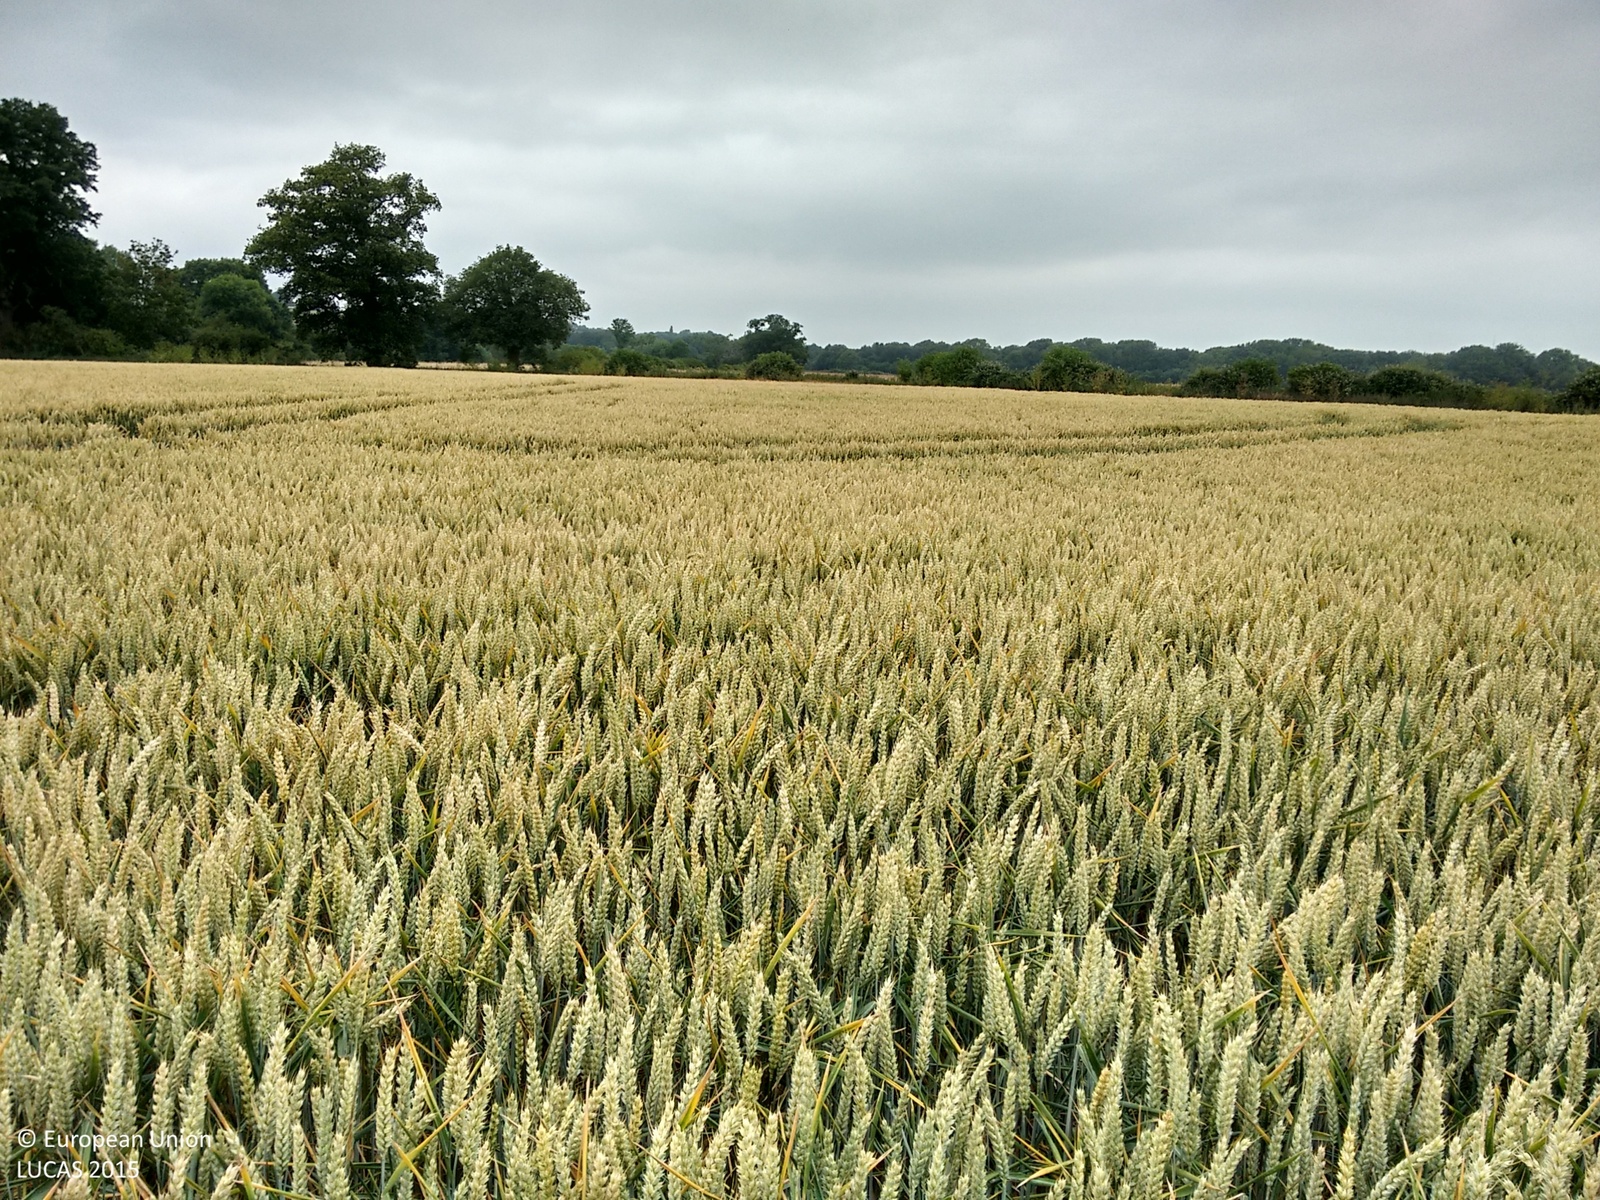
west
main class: Cropland
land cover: Common wheat
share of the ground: > 75 %
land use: Agriculture (excluding fallow land and kitchen gardens)
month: July
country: GB
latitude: 51.7615
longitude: -1.1301
